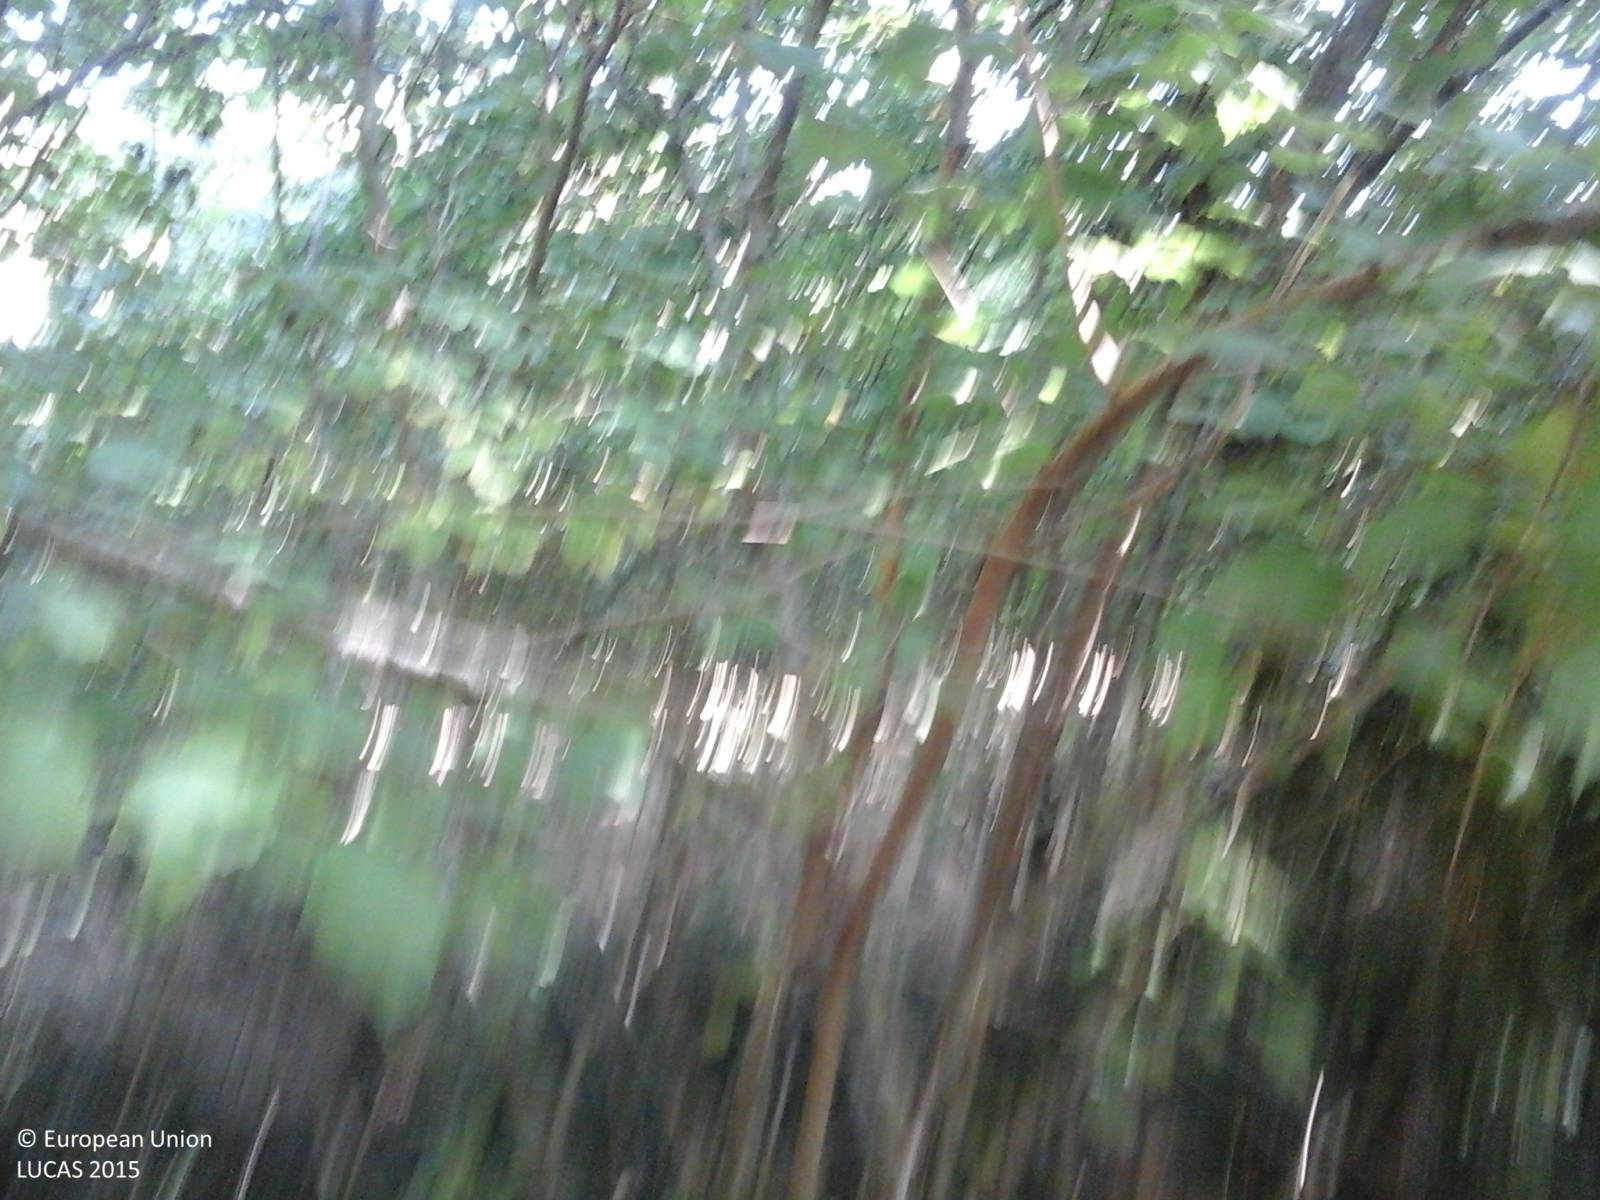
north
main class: Cropland
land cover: Nuts trees
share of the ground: > 75 %
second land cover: Grassland without tree/shrub cover
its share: 10 - 25 %
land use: Agriculture (excluding fallow land and kitchen gardens)
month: September
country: IT
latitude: 42.3763
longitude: 12.2391
